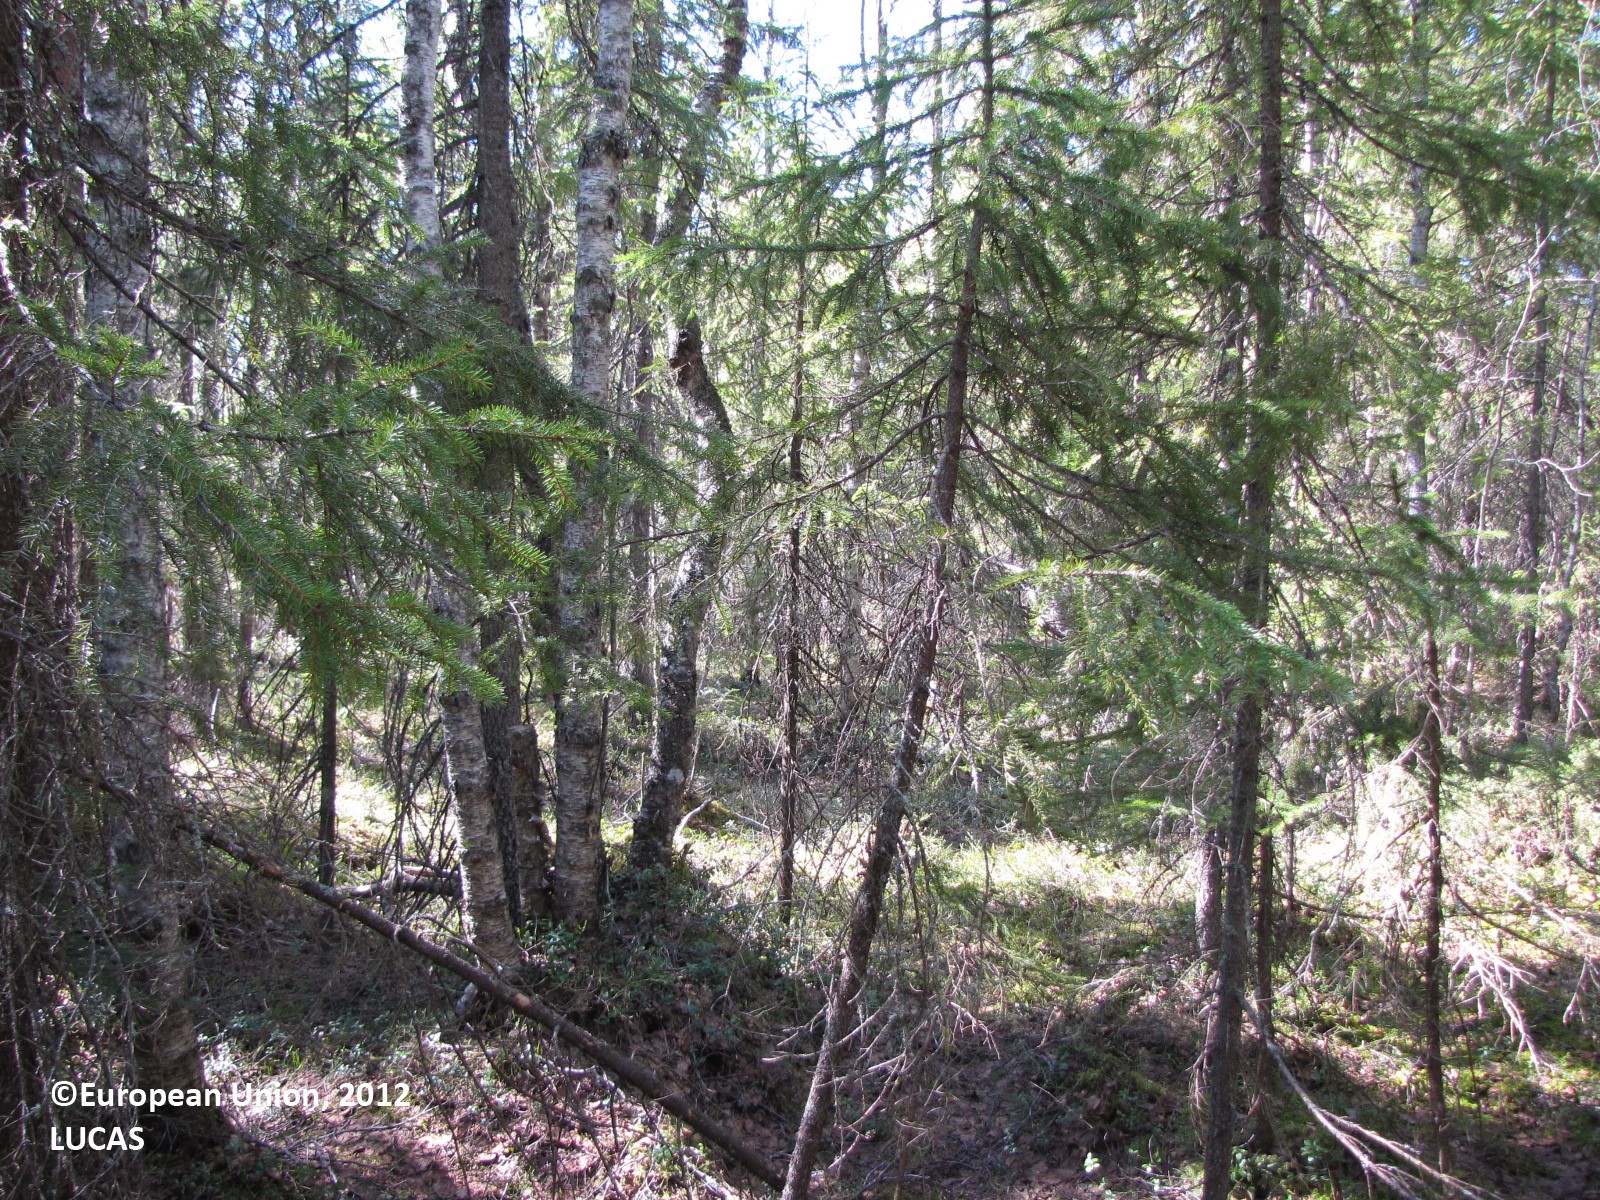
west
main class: Woodland
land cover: Spruce dominated mixed woodland
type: boreal forest
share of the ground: > 75 %
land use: Forestry
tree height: > 5 m
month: May
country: FI
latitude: 65.7569
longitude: 24.7031
